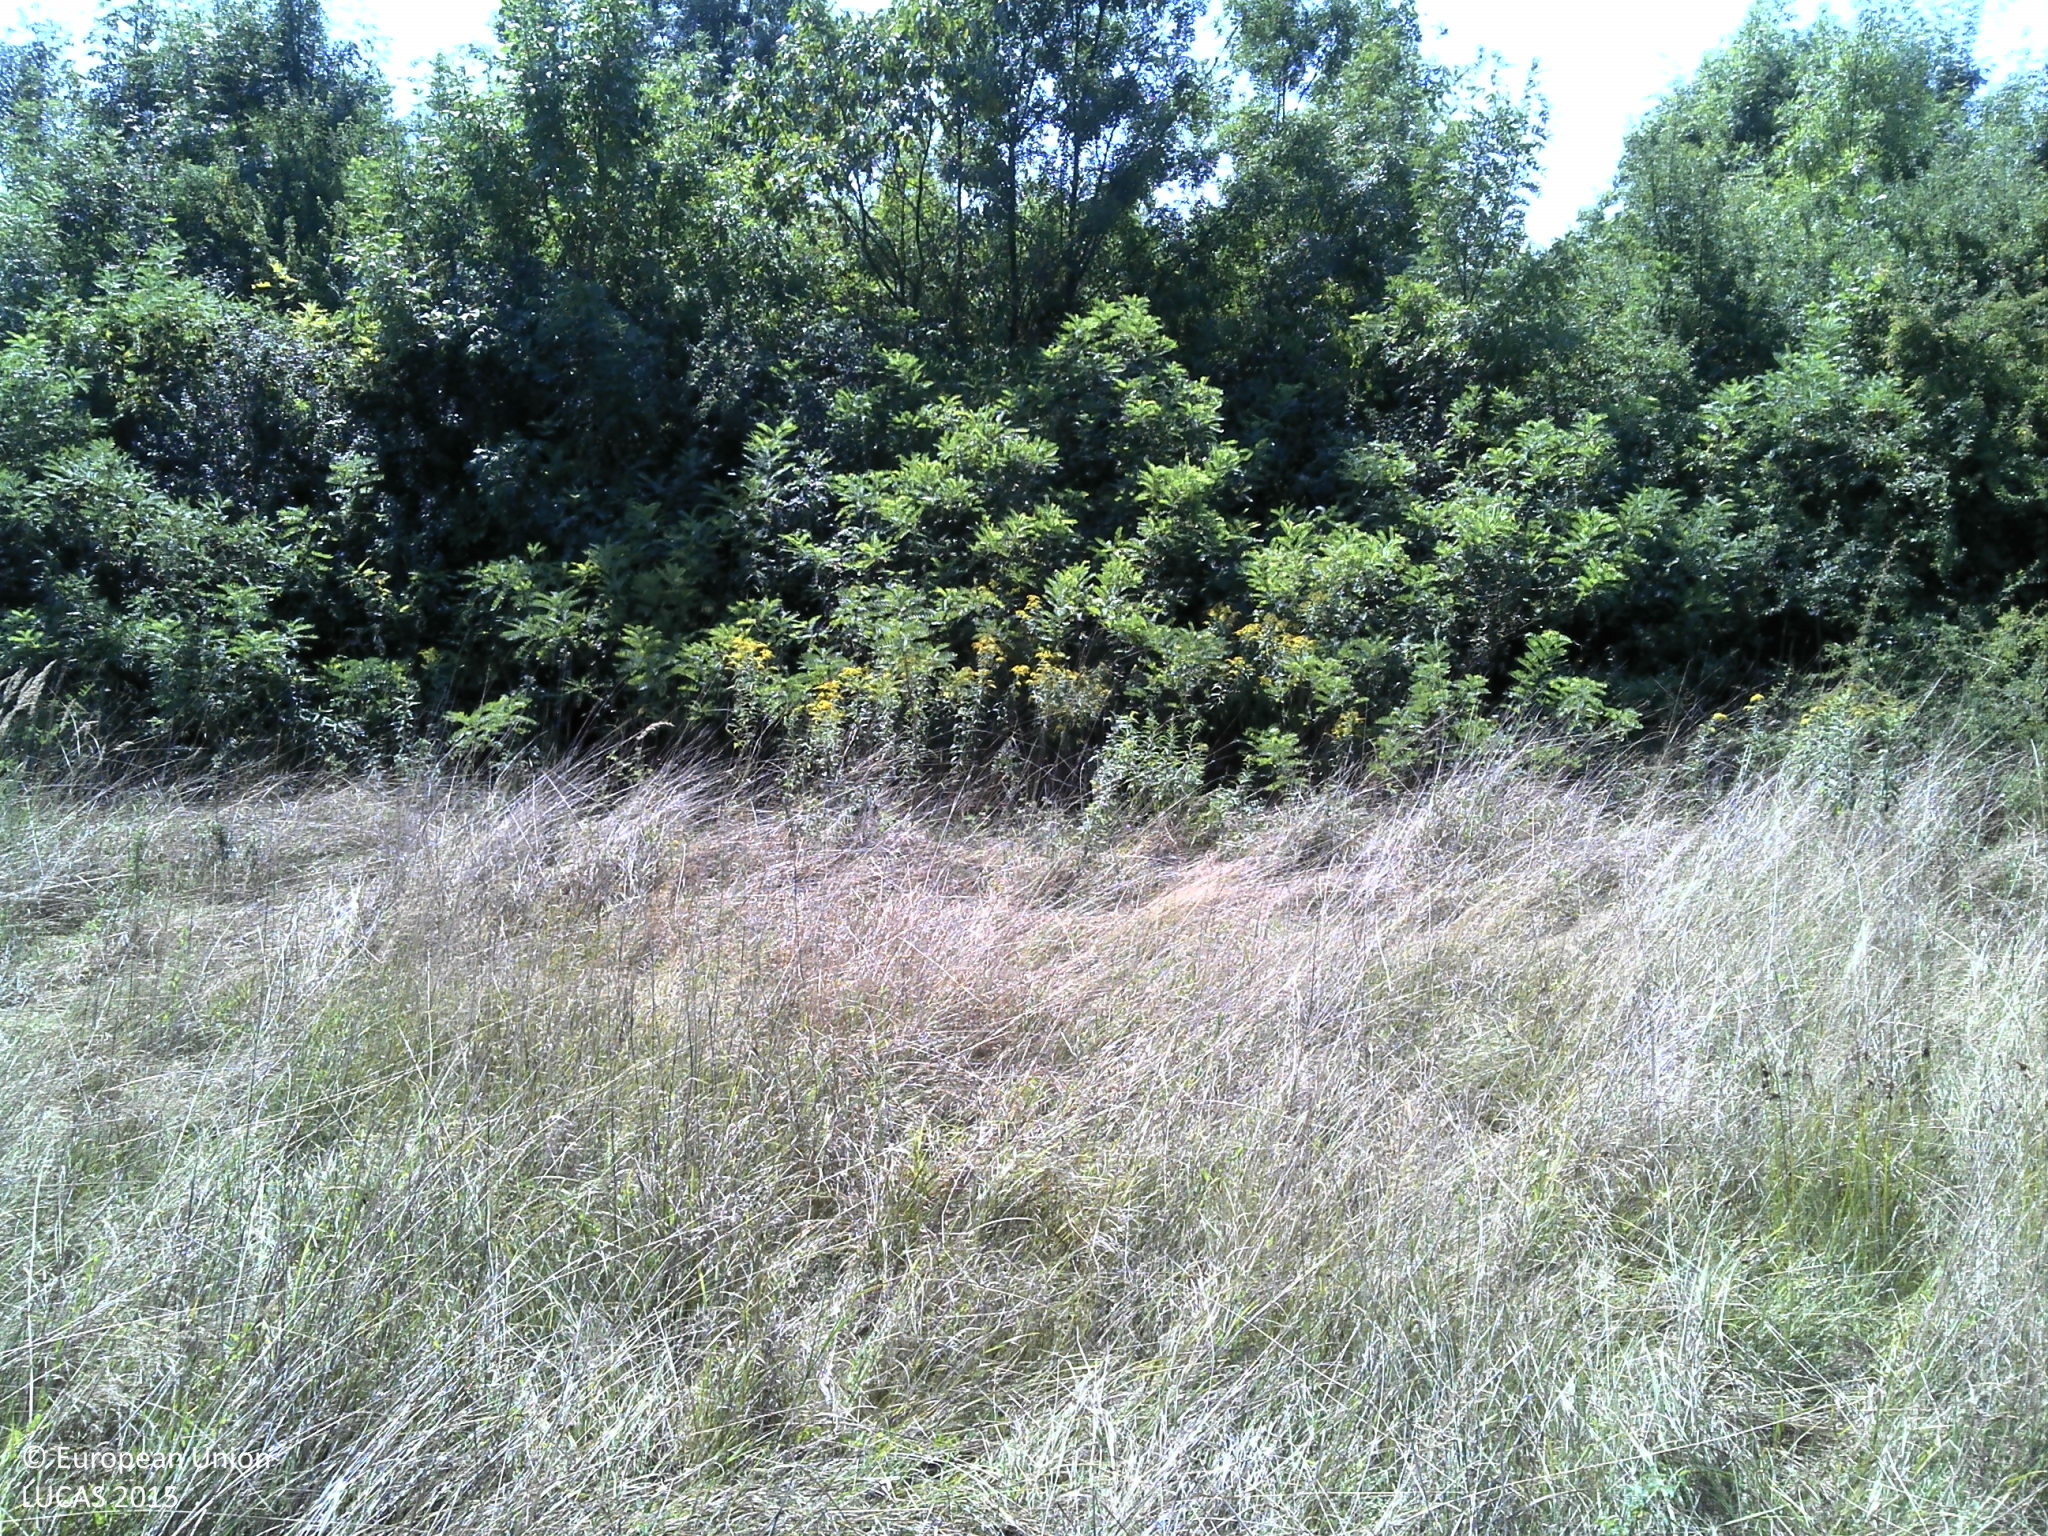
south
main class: Grassland
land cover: Grassland without tree/shrub cover
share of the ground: > 75 %
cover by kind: herbaceous plants 100 %
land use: Agriculture (excluding fallow land and kitchen gardens)
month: August
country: HR
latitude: 45.4755
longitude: 16.3554
